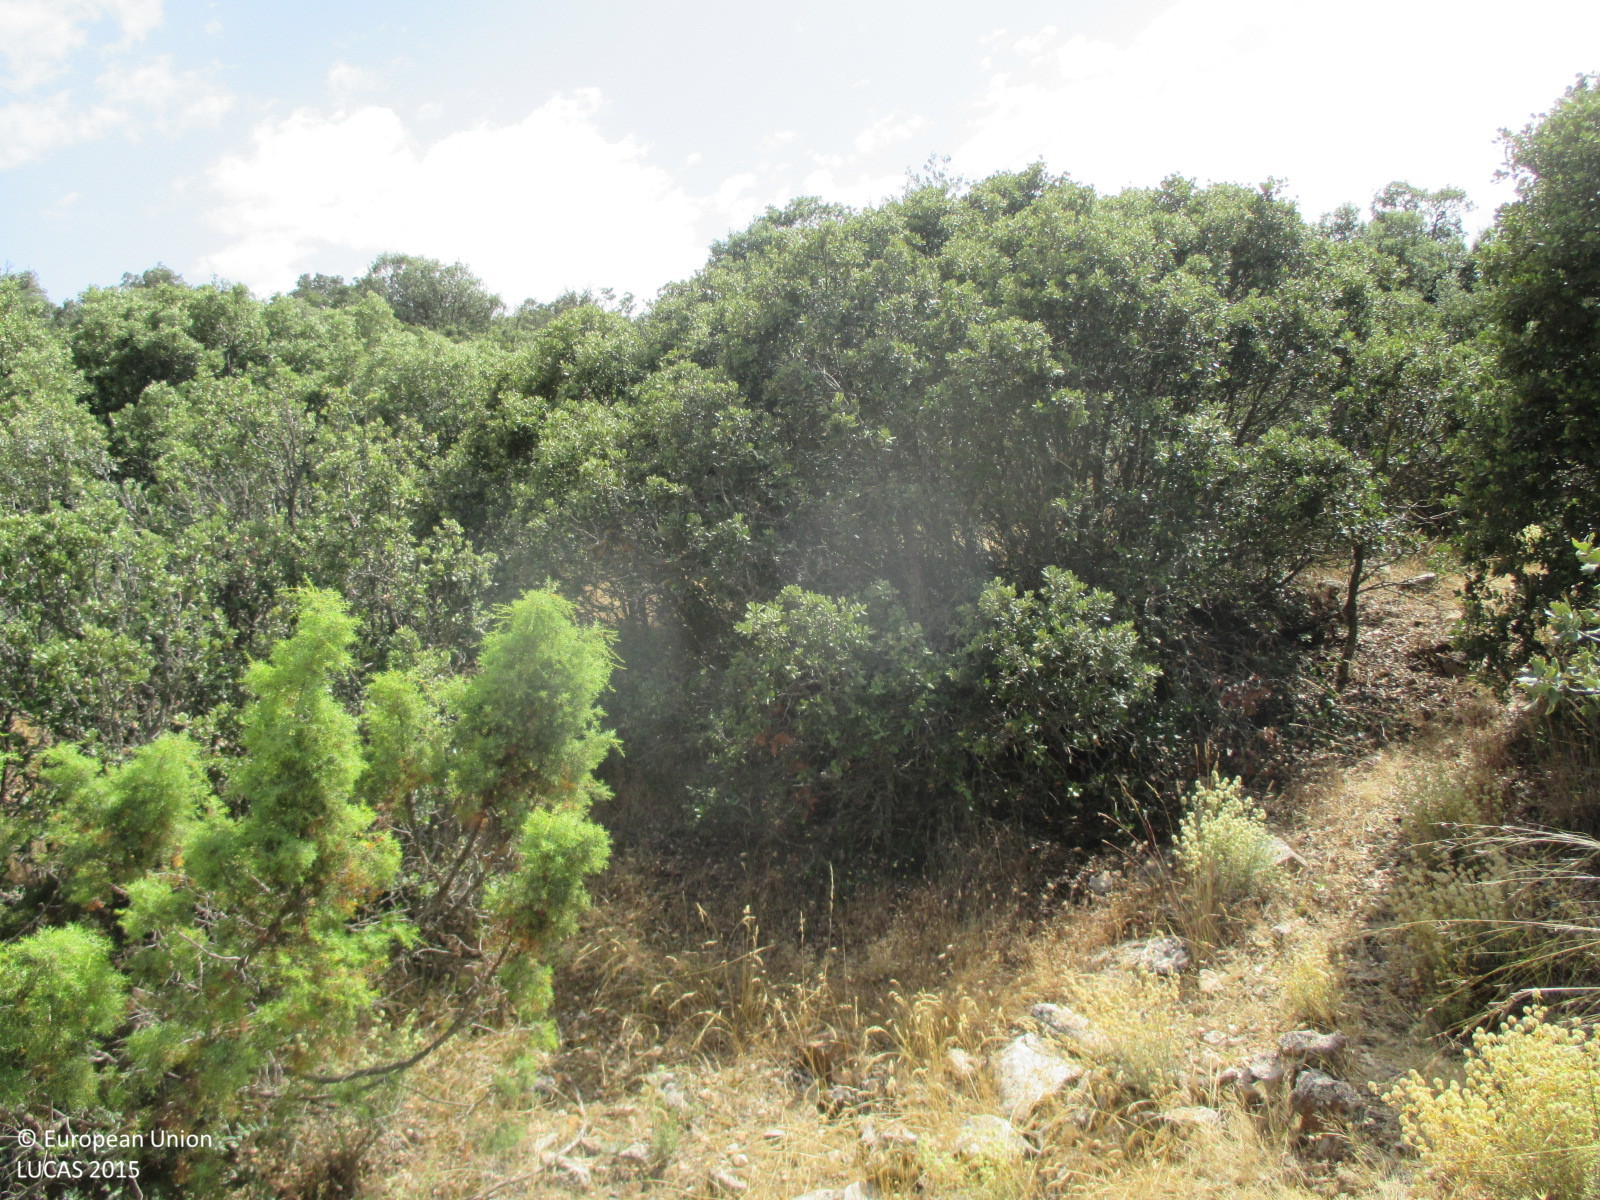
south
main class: Woodland
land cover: Broadleaved woodland
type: broadleaved evergreen forest
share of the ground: 50 - 75 %
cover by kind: broadleaved forest trees 60 %, shrubs 20 %, herbaceous plants 20 %
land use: Semi-natural and natural areas not in use
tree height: < 5 m
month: June
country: ES
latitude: 37.6326
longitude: -2.3716
